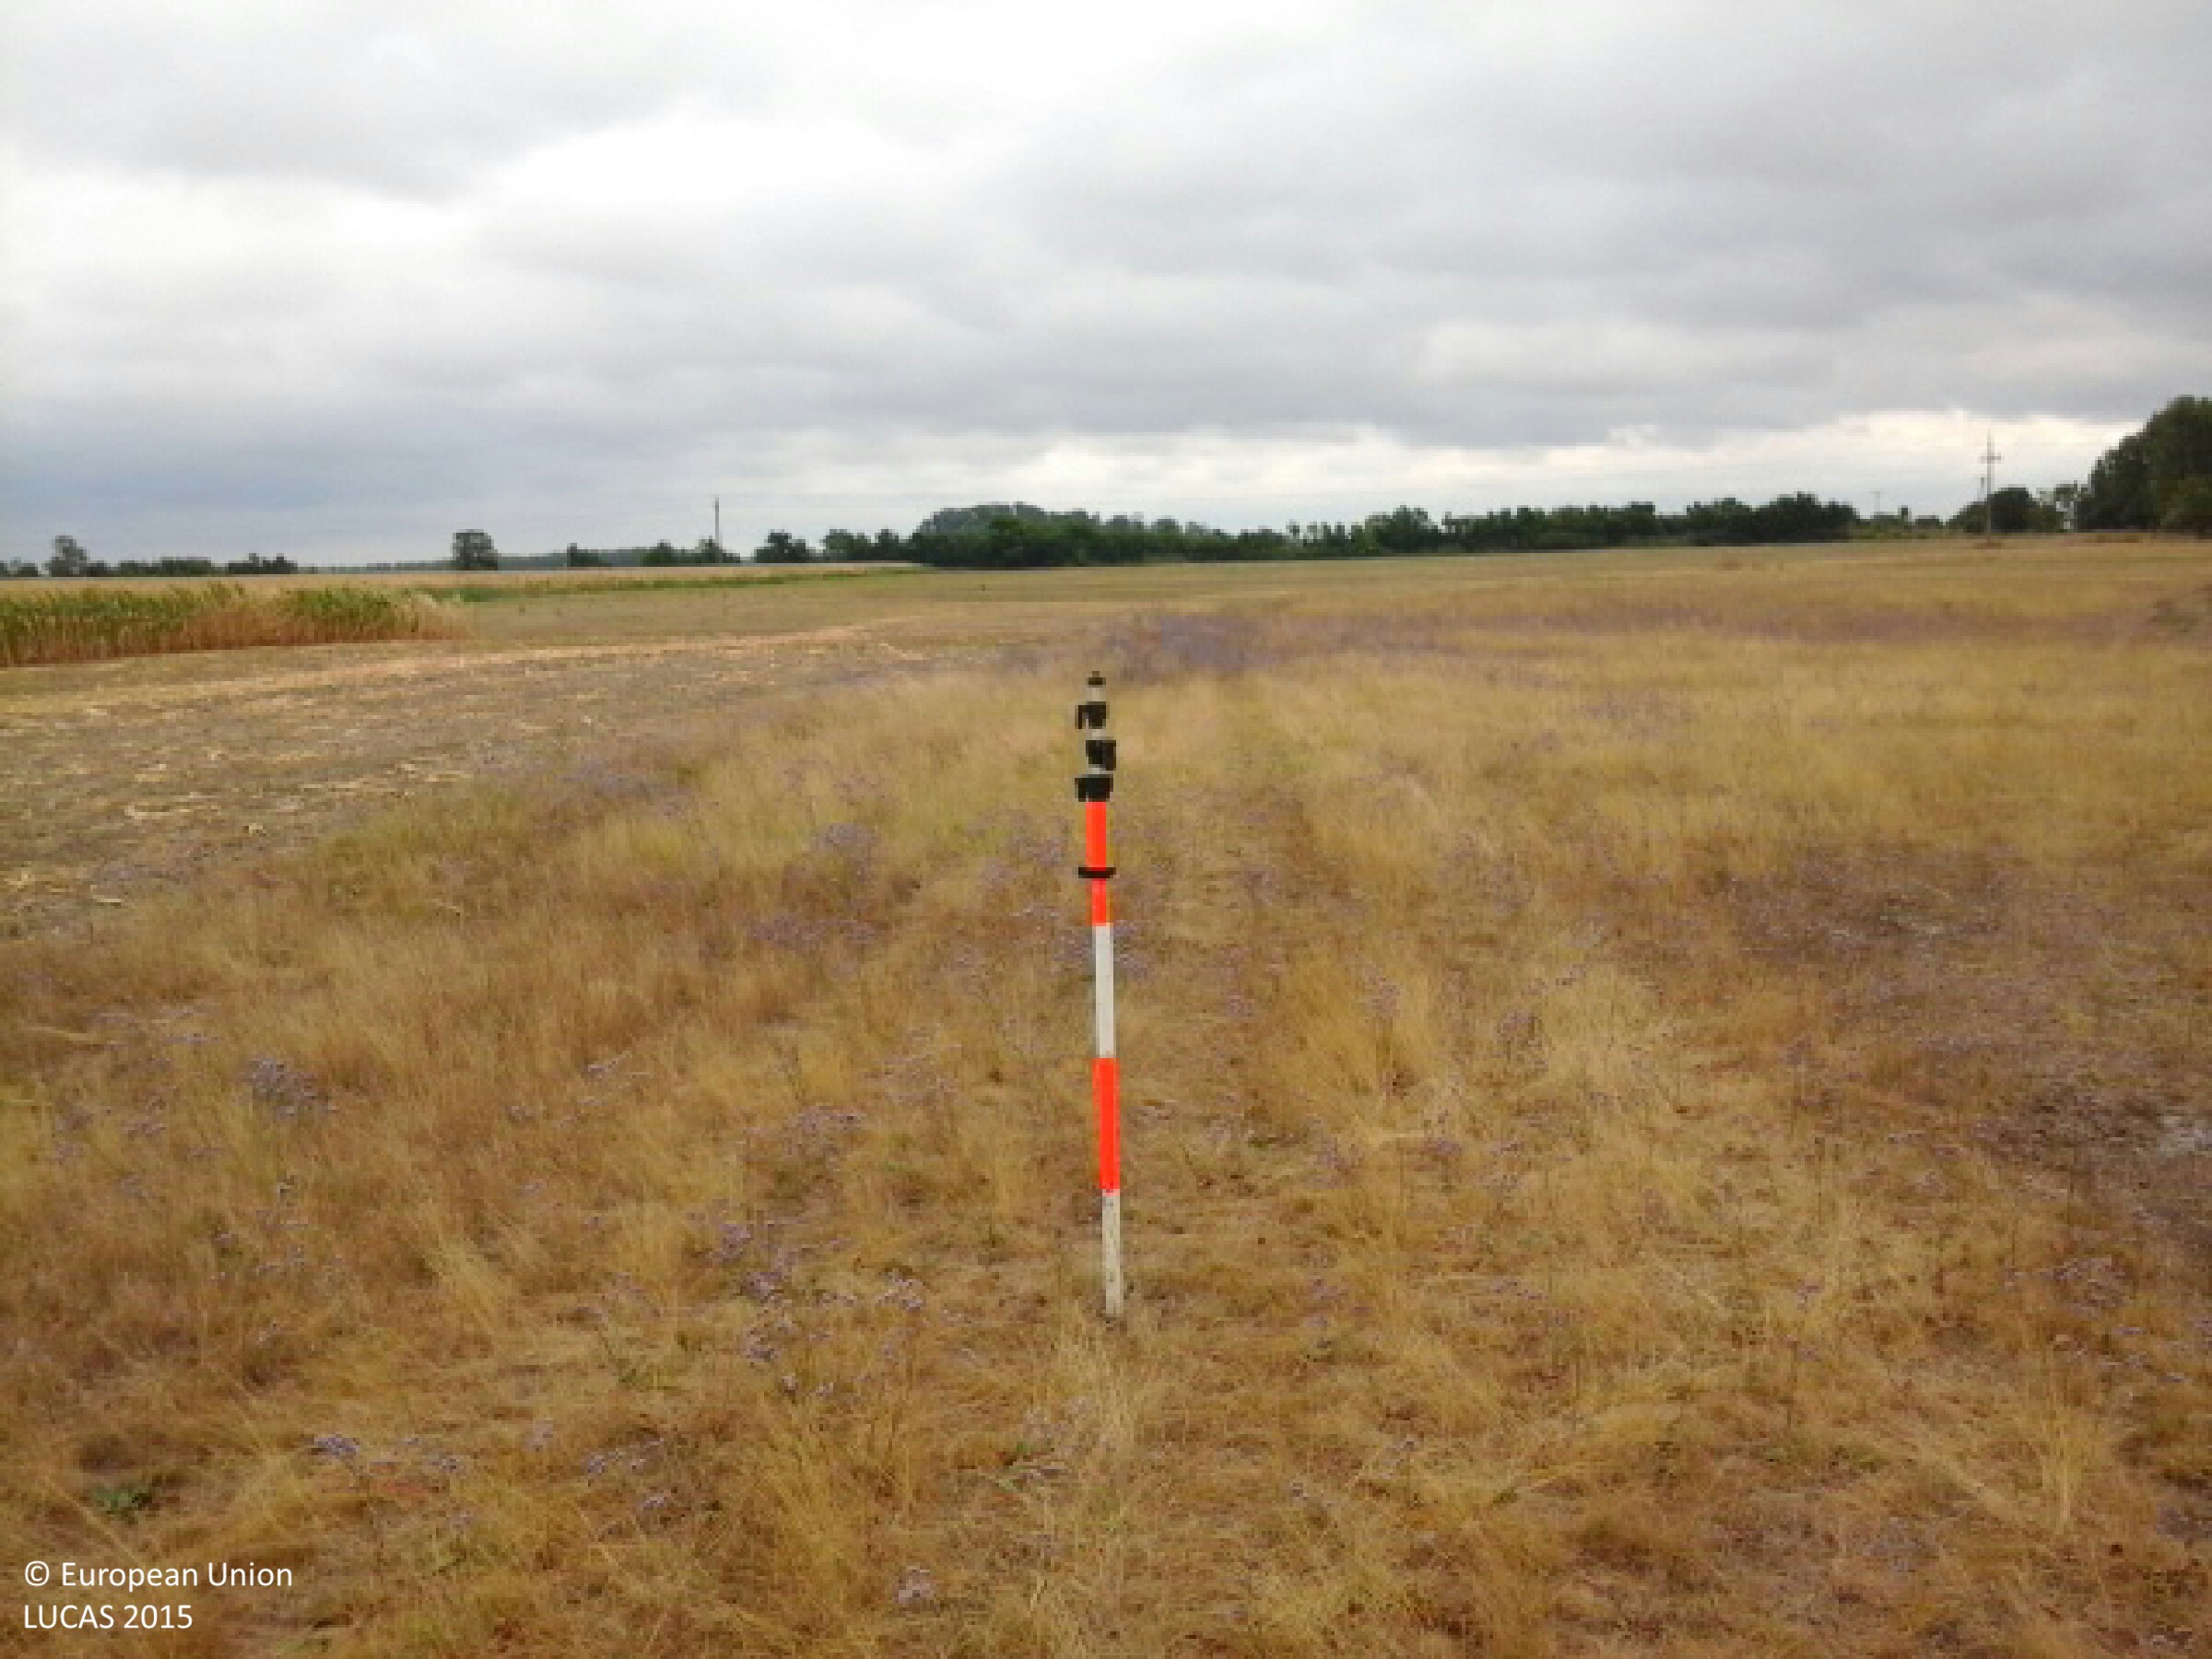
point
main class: Grassland
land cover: Grassland without tree/shrub cover
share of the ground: > 75 %
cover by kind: herbaceous plants 100 %
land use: Agriculture (excluding fallow land and kitchen gardens)
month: August
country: HU
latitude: 47.1412
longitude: 21.5530
